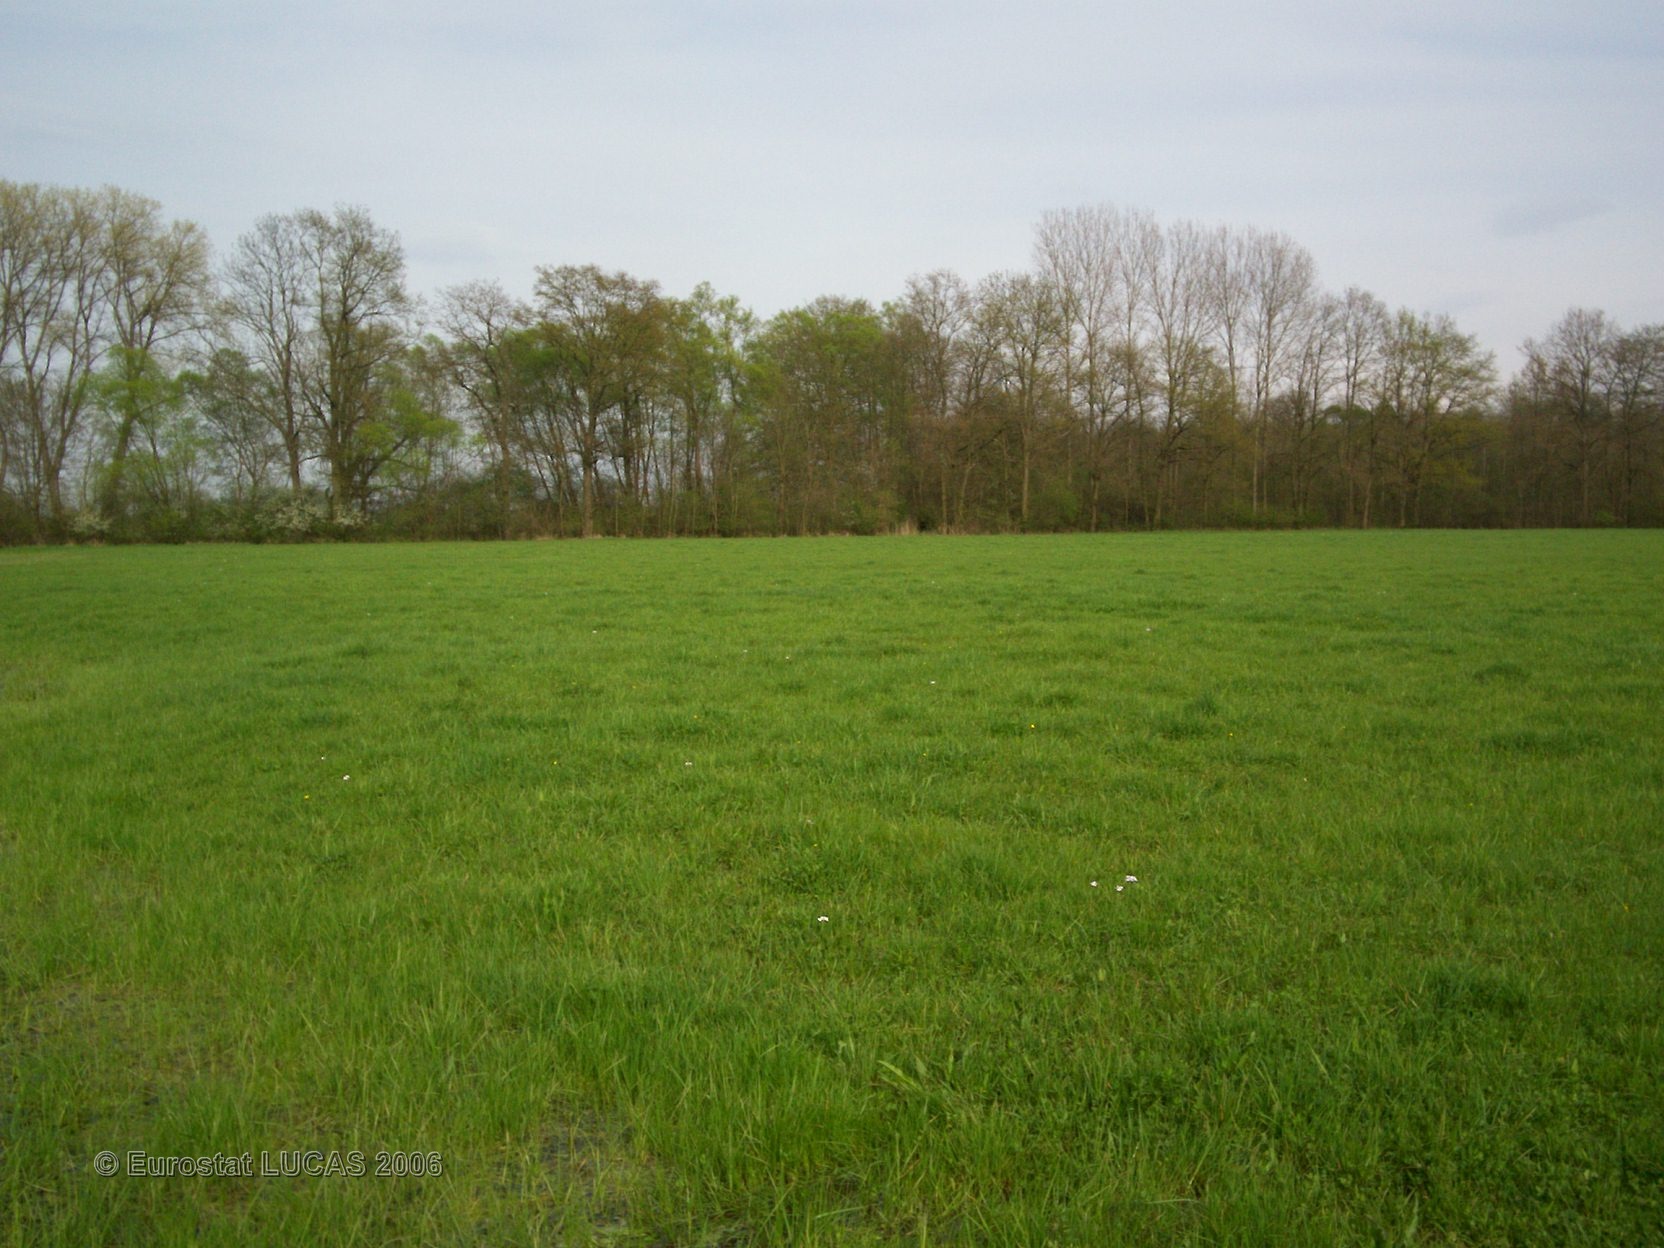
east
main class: Grassland
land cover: Grassland without tree/shrub cover
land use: Agriculture (excluding fallow land and kitchen gardens)
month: April
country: FR
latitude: 48.1750
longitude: 7.4056
